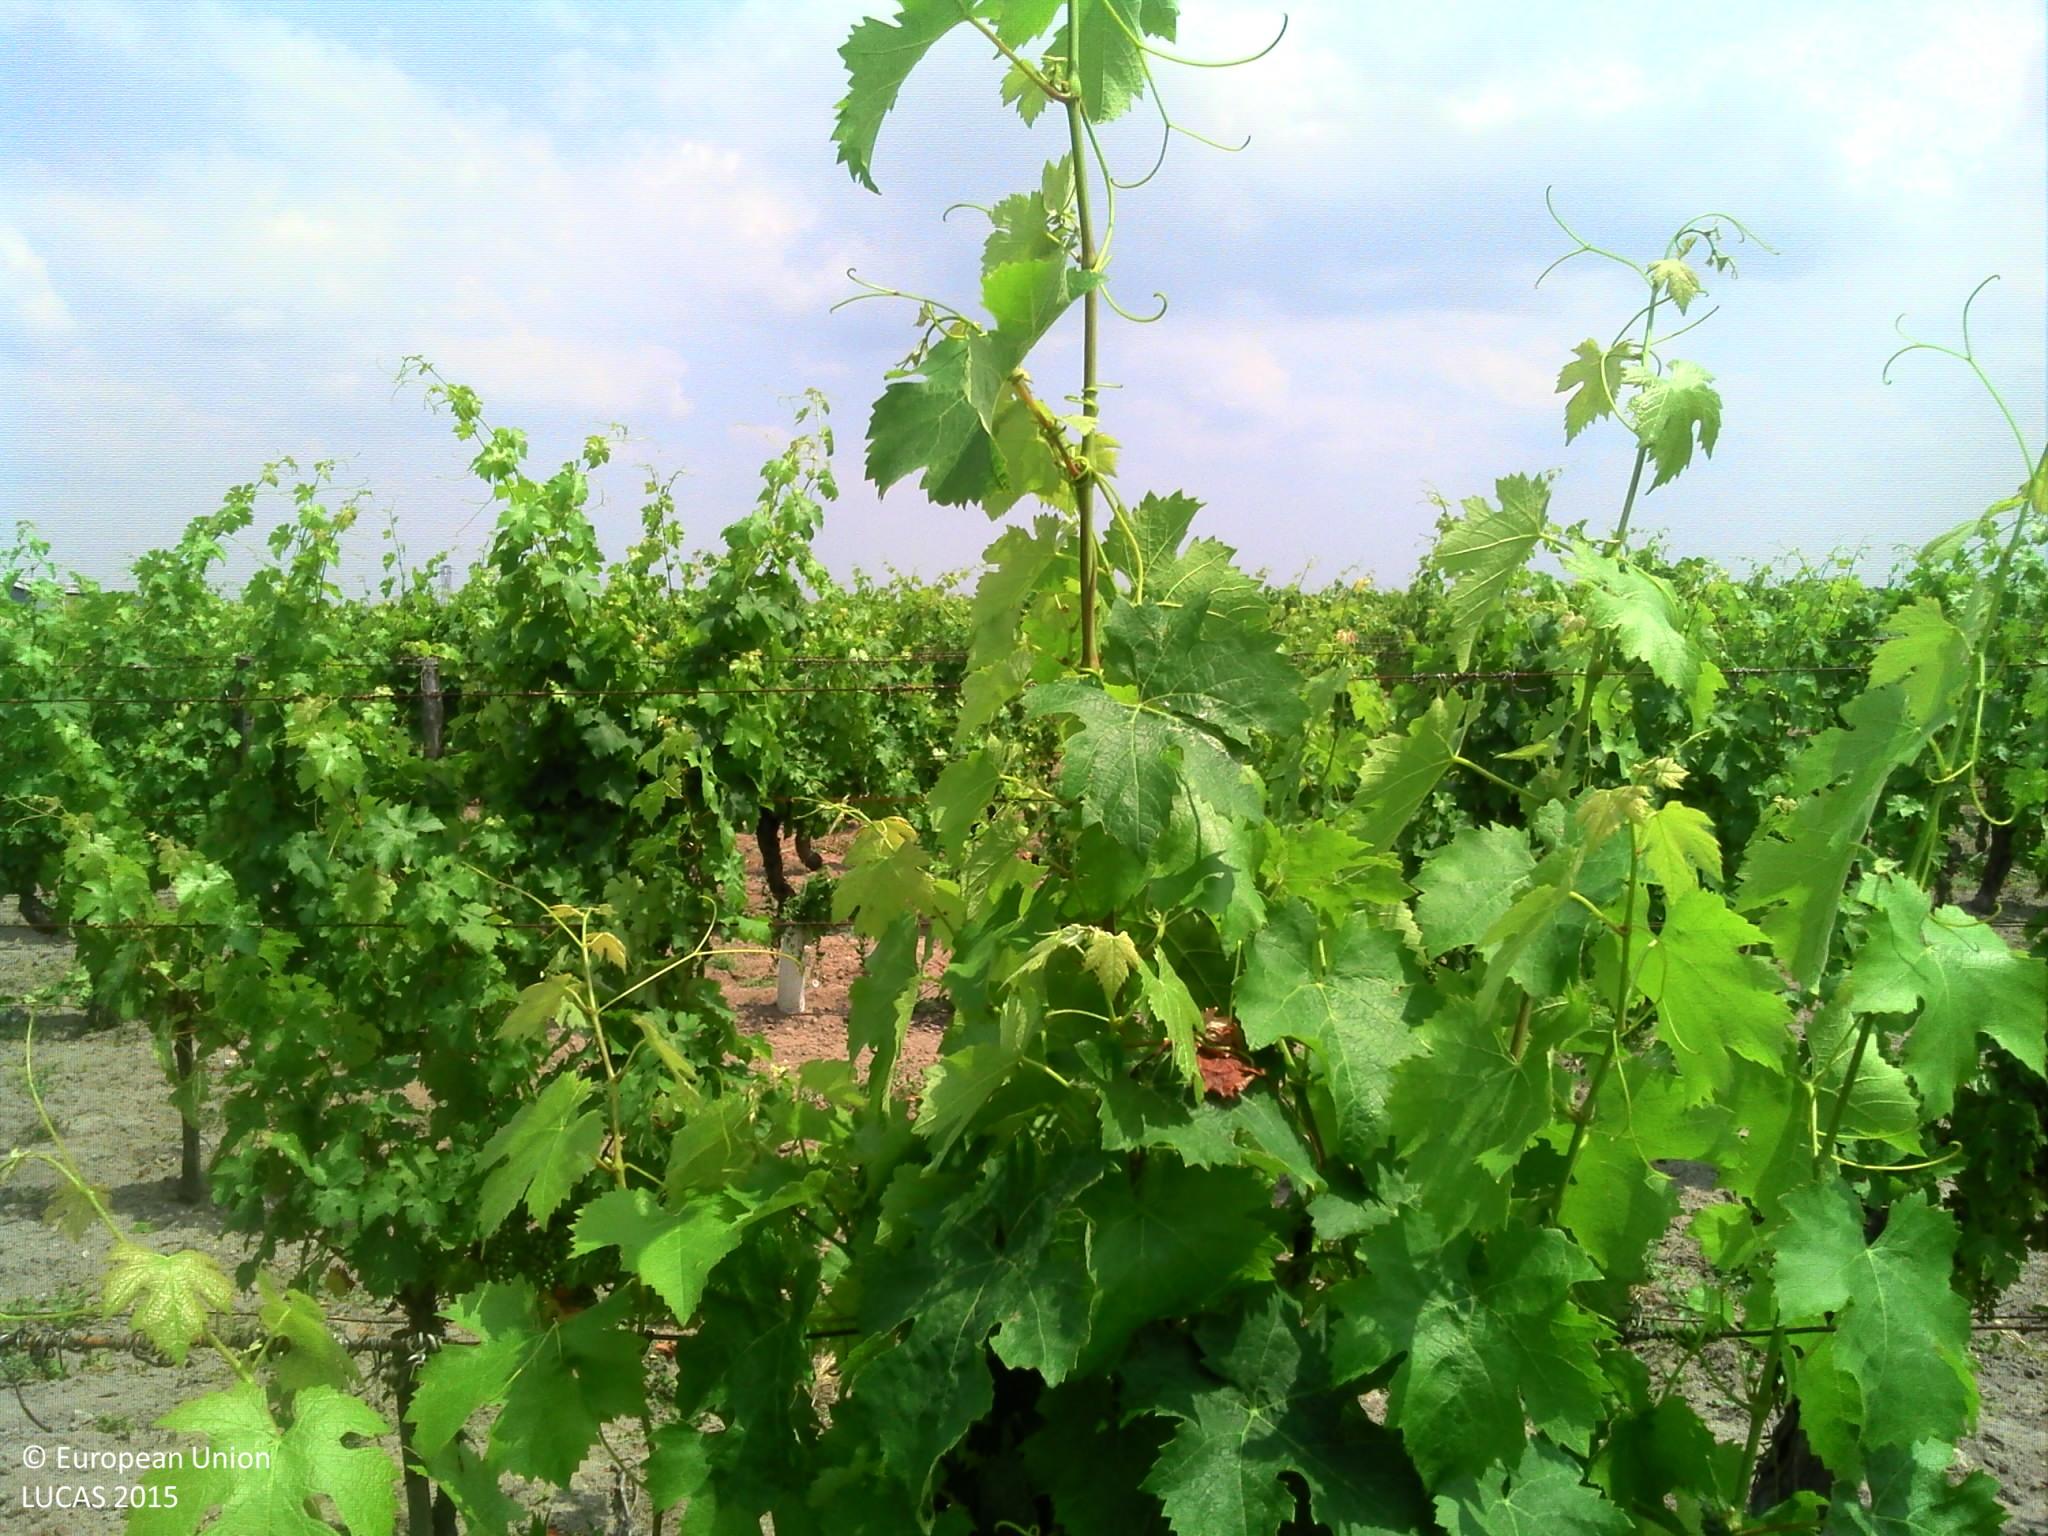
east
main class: Cropland
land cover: Vineyards
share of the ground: 25 - 50 %
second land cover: Other bare soil
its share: > 75 %
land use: Agriculture (excluding fallow land and kitchen gardens)
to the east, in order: Vineyards; Other bare soil; Grass margins; Tracks; Grass margins; Vineyards; Other bare soil; Grass margins; Tracks; Grass margins; Vineyards
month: July
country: FR
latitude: 47.2897
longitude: 0.1252
